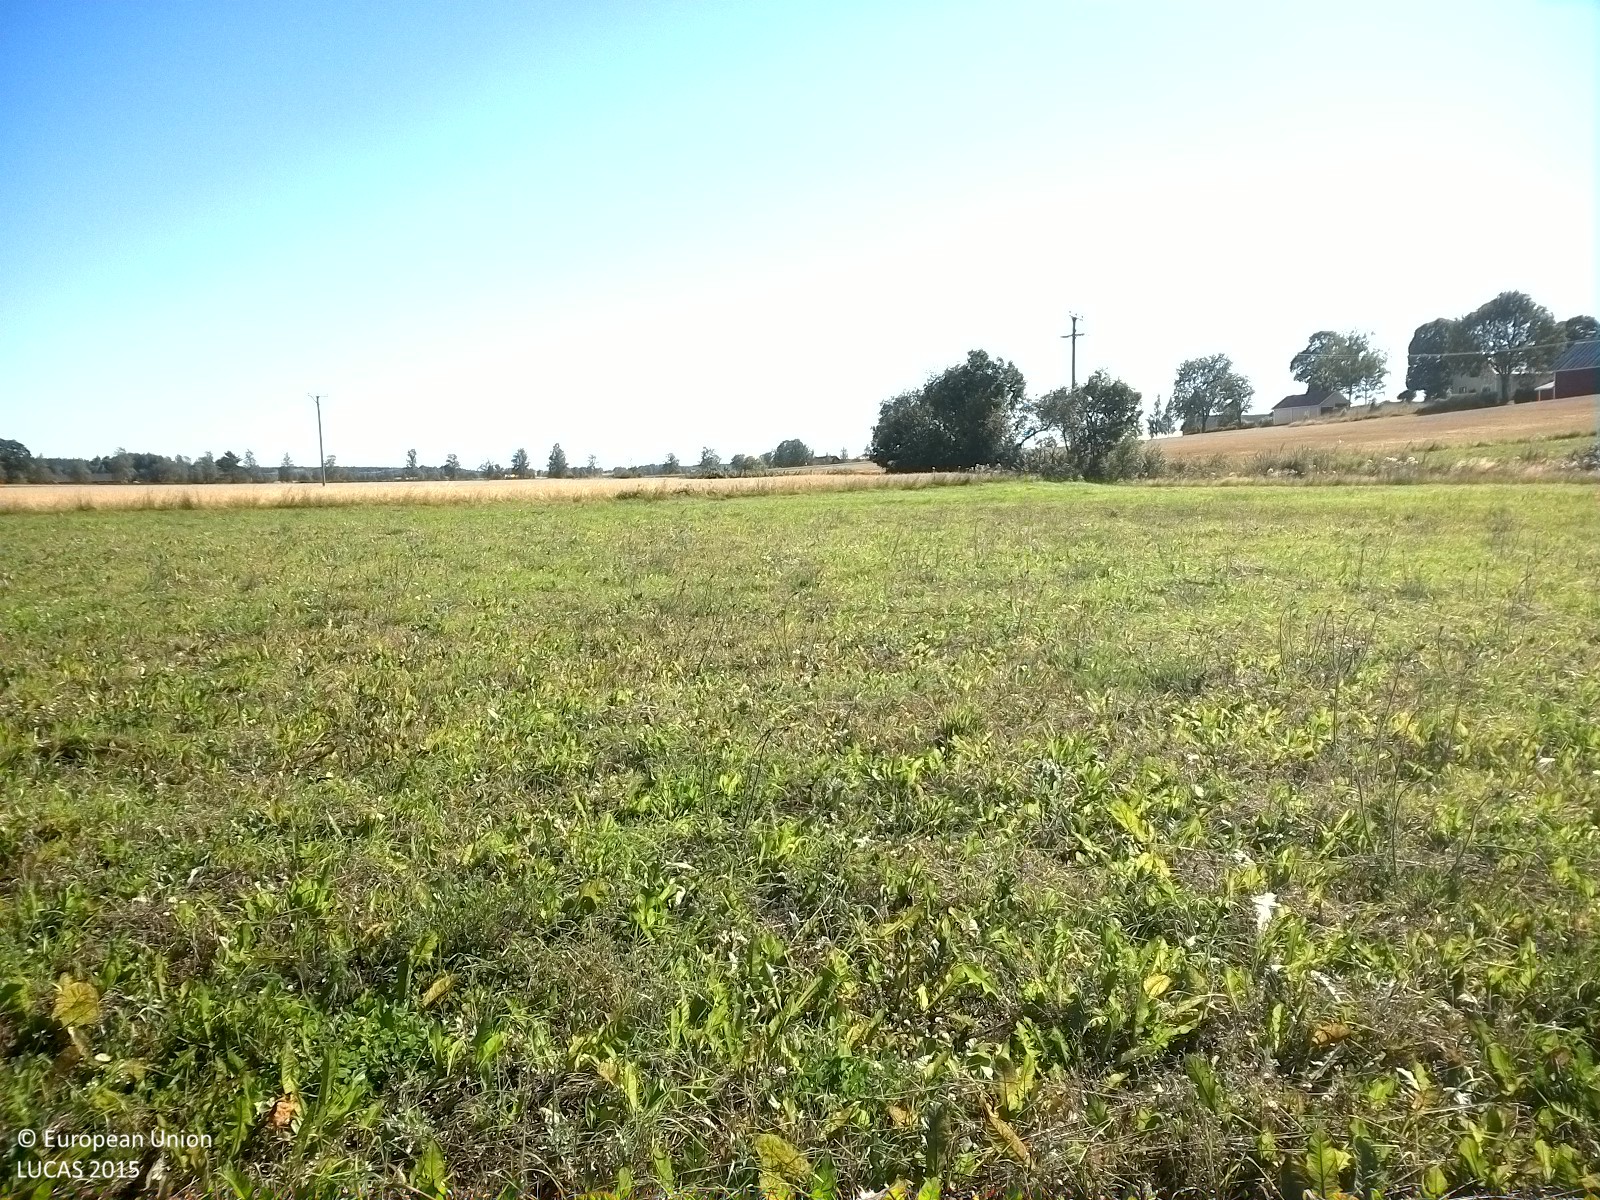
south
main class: Grassland
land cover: Grassland without tree/shrub cover
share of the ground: > 75 %
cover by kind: herbaceous plants 100 %
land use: Agriculture (excluding fallow land and kitchen gardens)
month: August
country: SE
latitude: 59.3845
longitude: 15.1141
